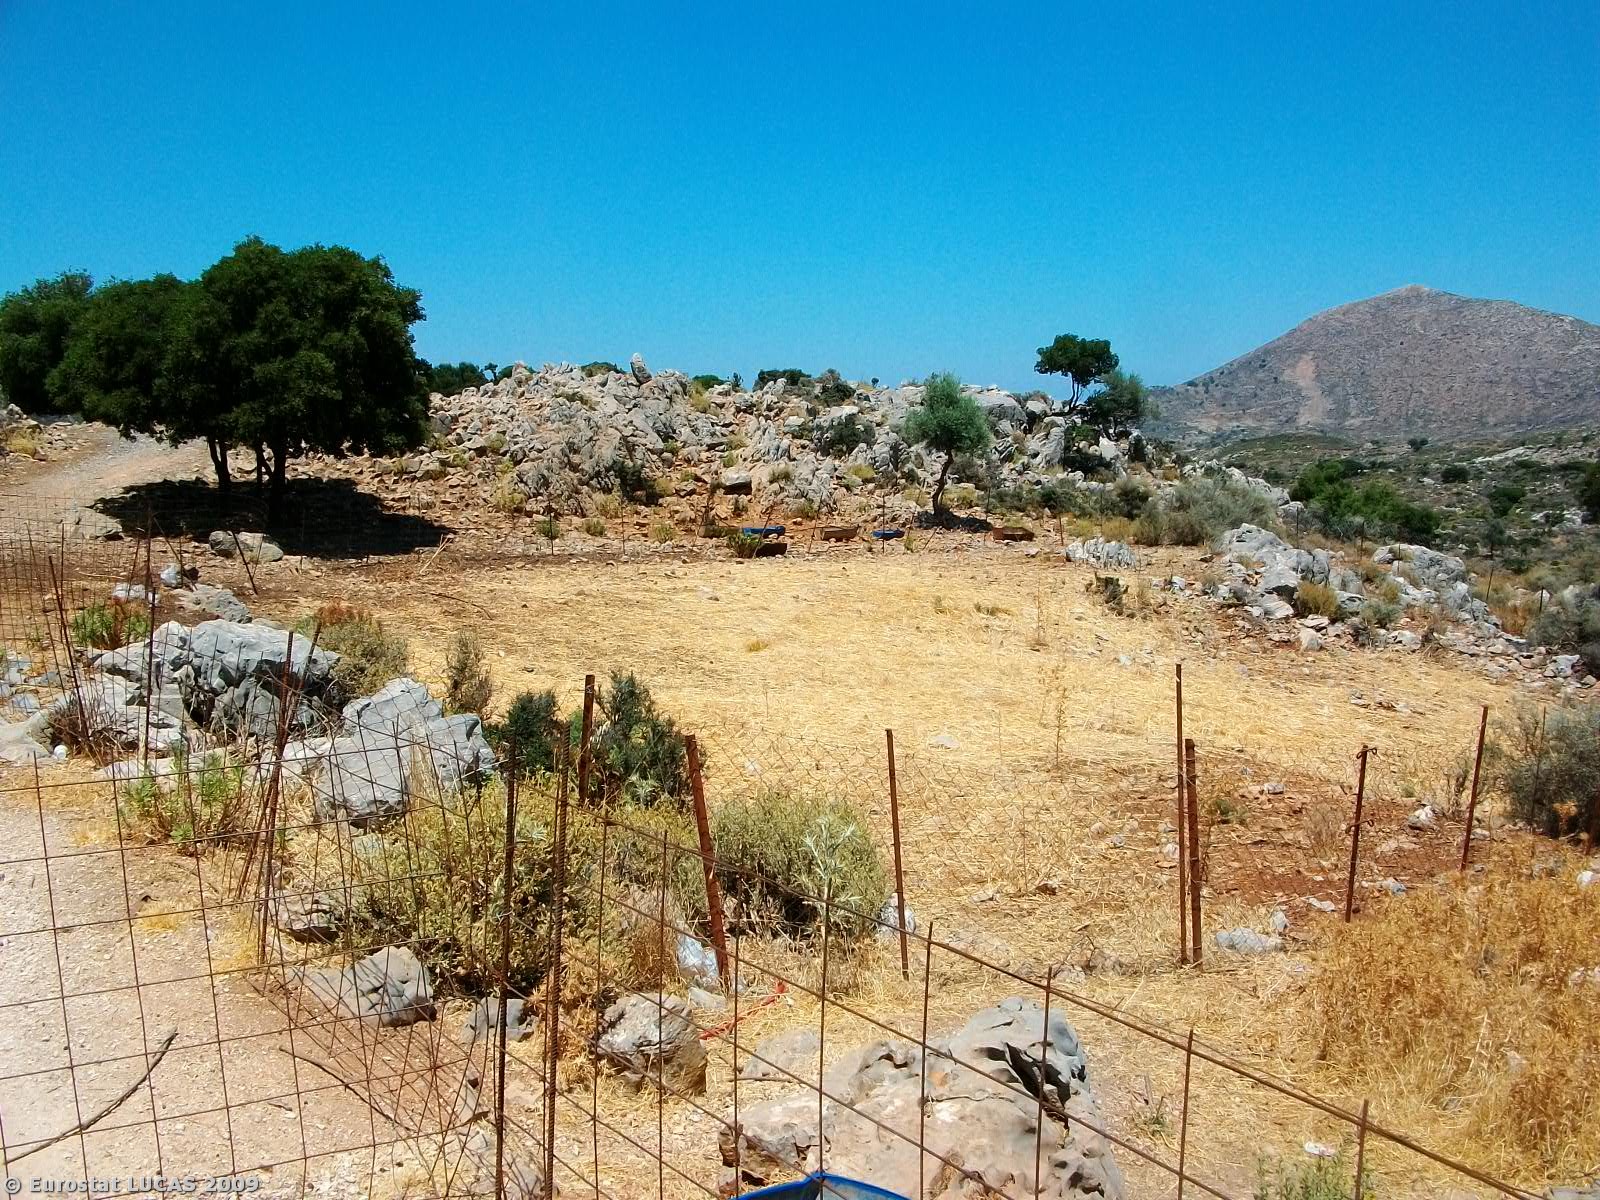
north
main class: Shrubland
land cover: Shrubland without tree cover
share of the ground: 50 - 75 %
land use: Unused
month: July
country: GR
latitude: 35.3257
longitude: 24.9408
